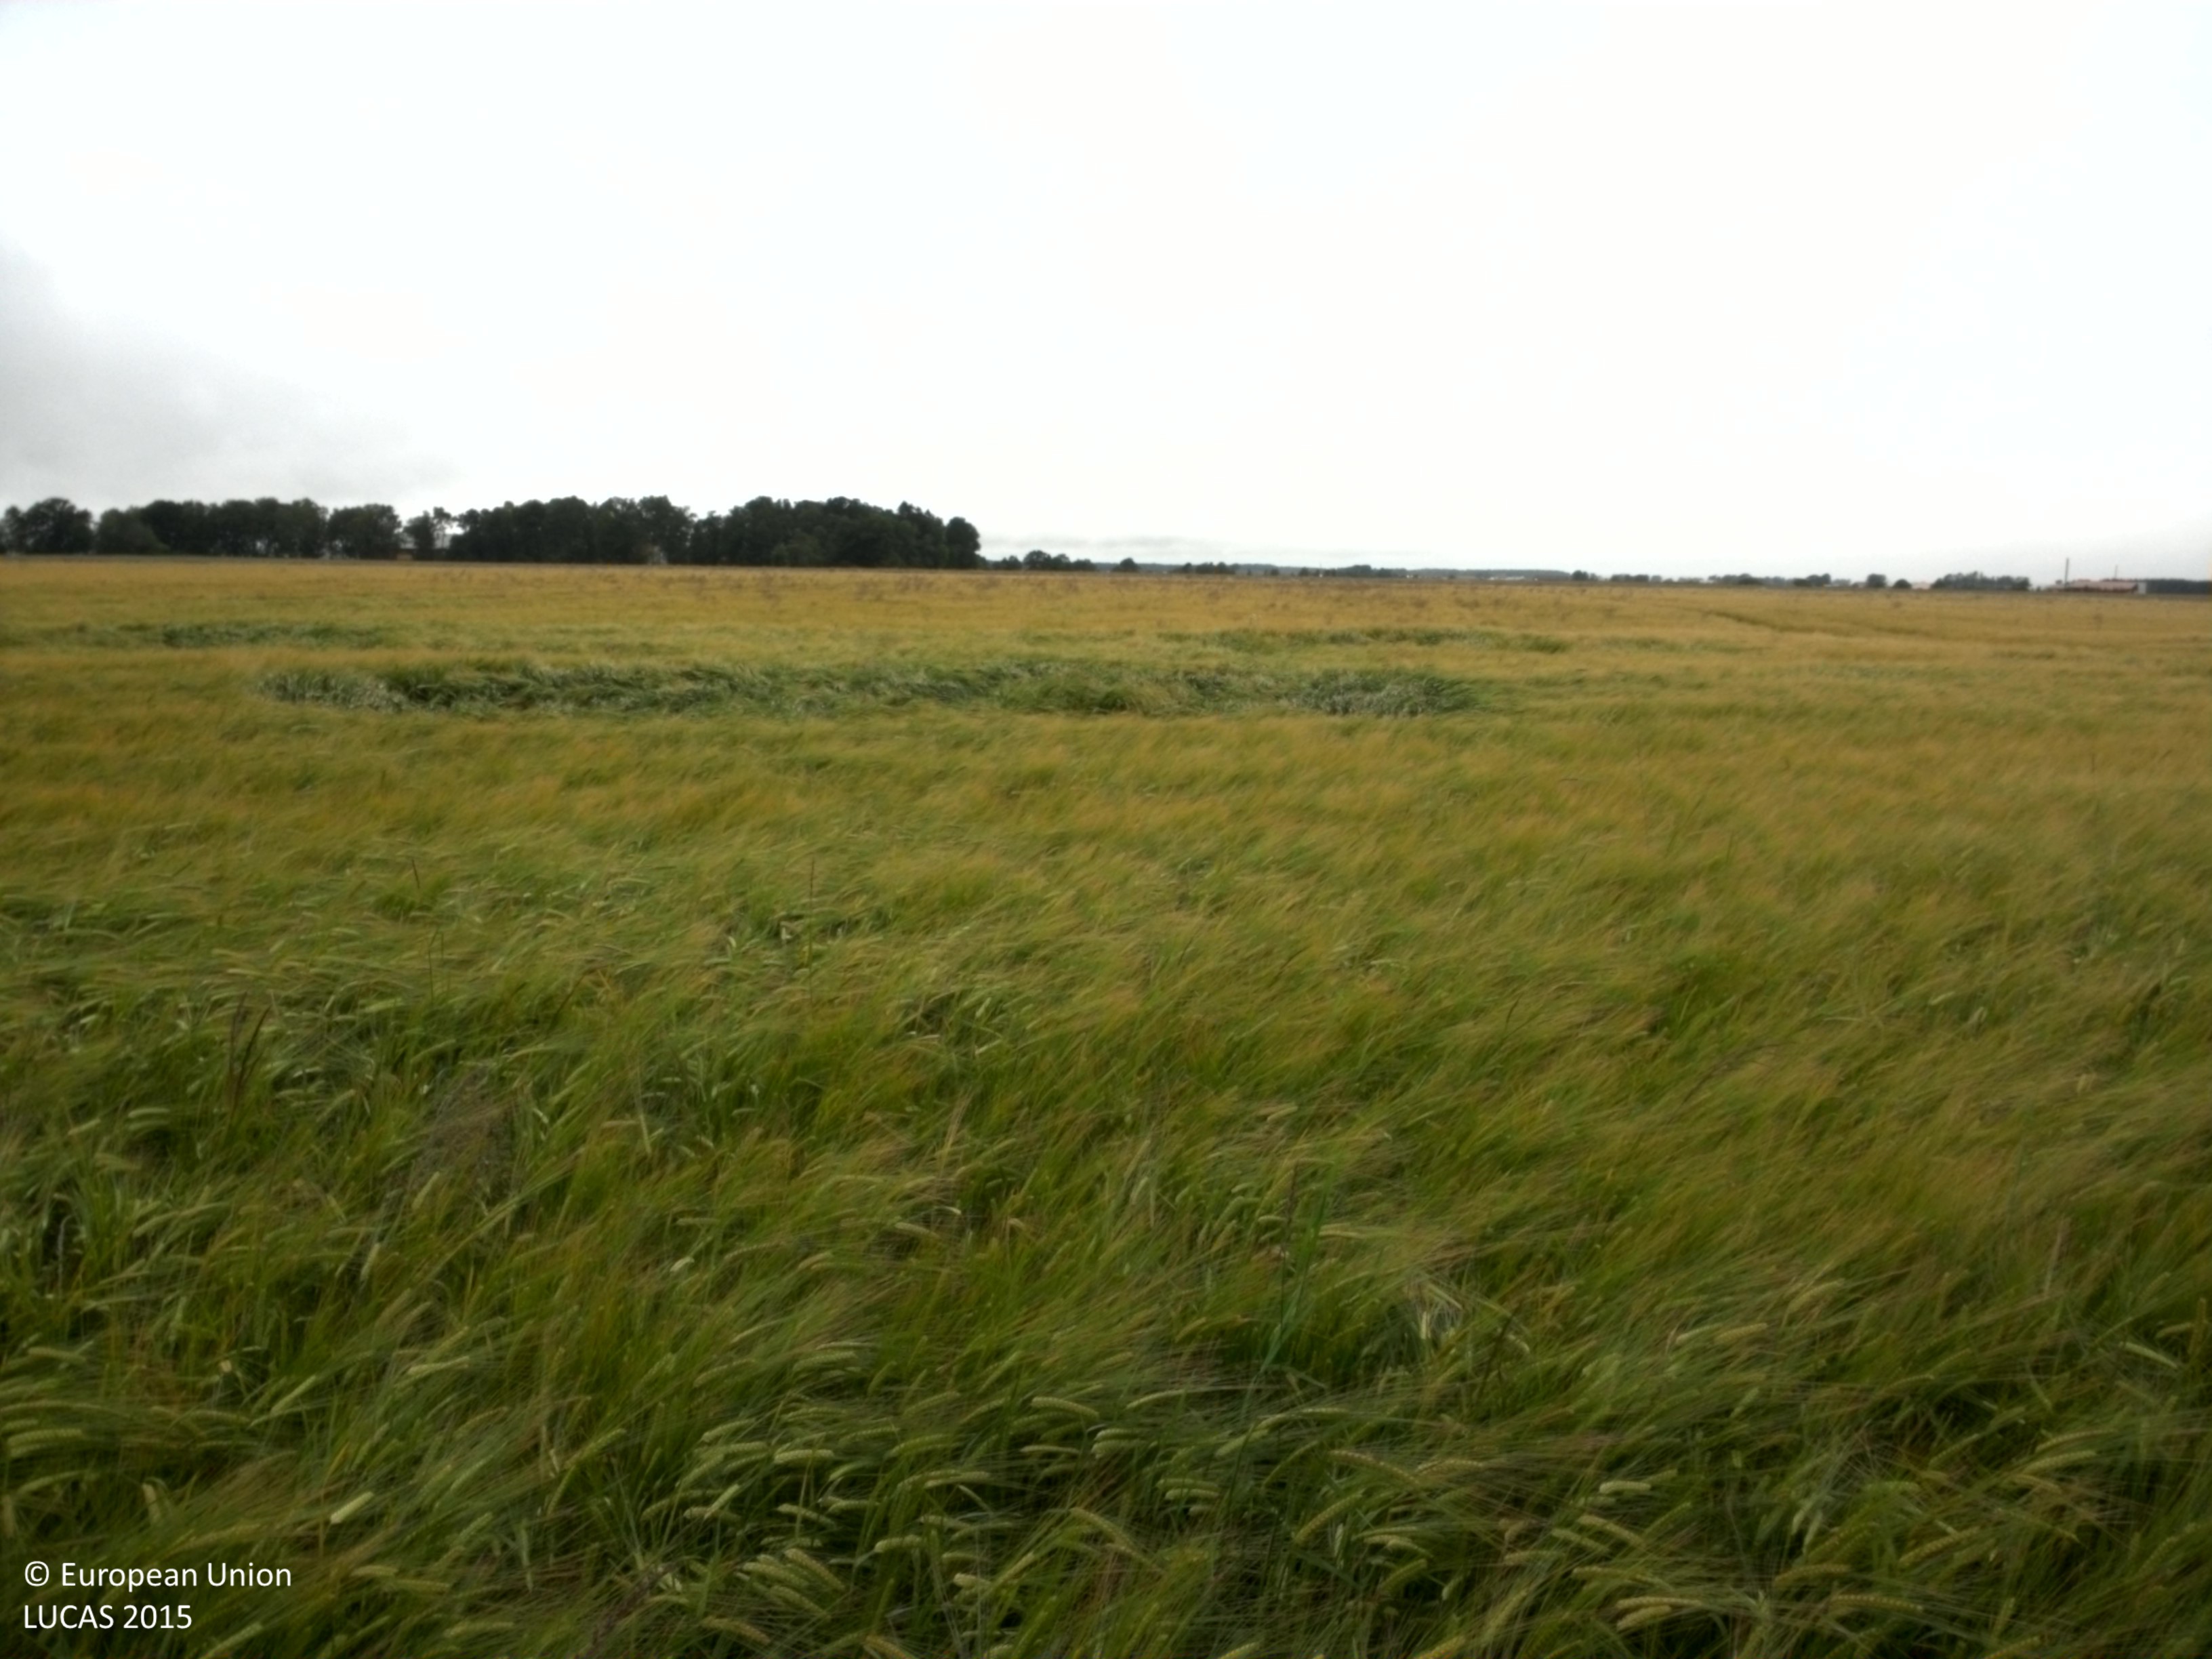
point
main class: Cropland
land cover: Barley
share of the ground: > 75 %
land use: Agriculture (excluding fallow land and kitchen gardens)
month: July
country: SE
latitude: 58.4327
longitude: 13.2311
